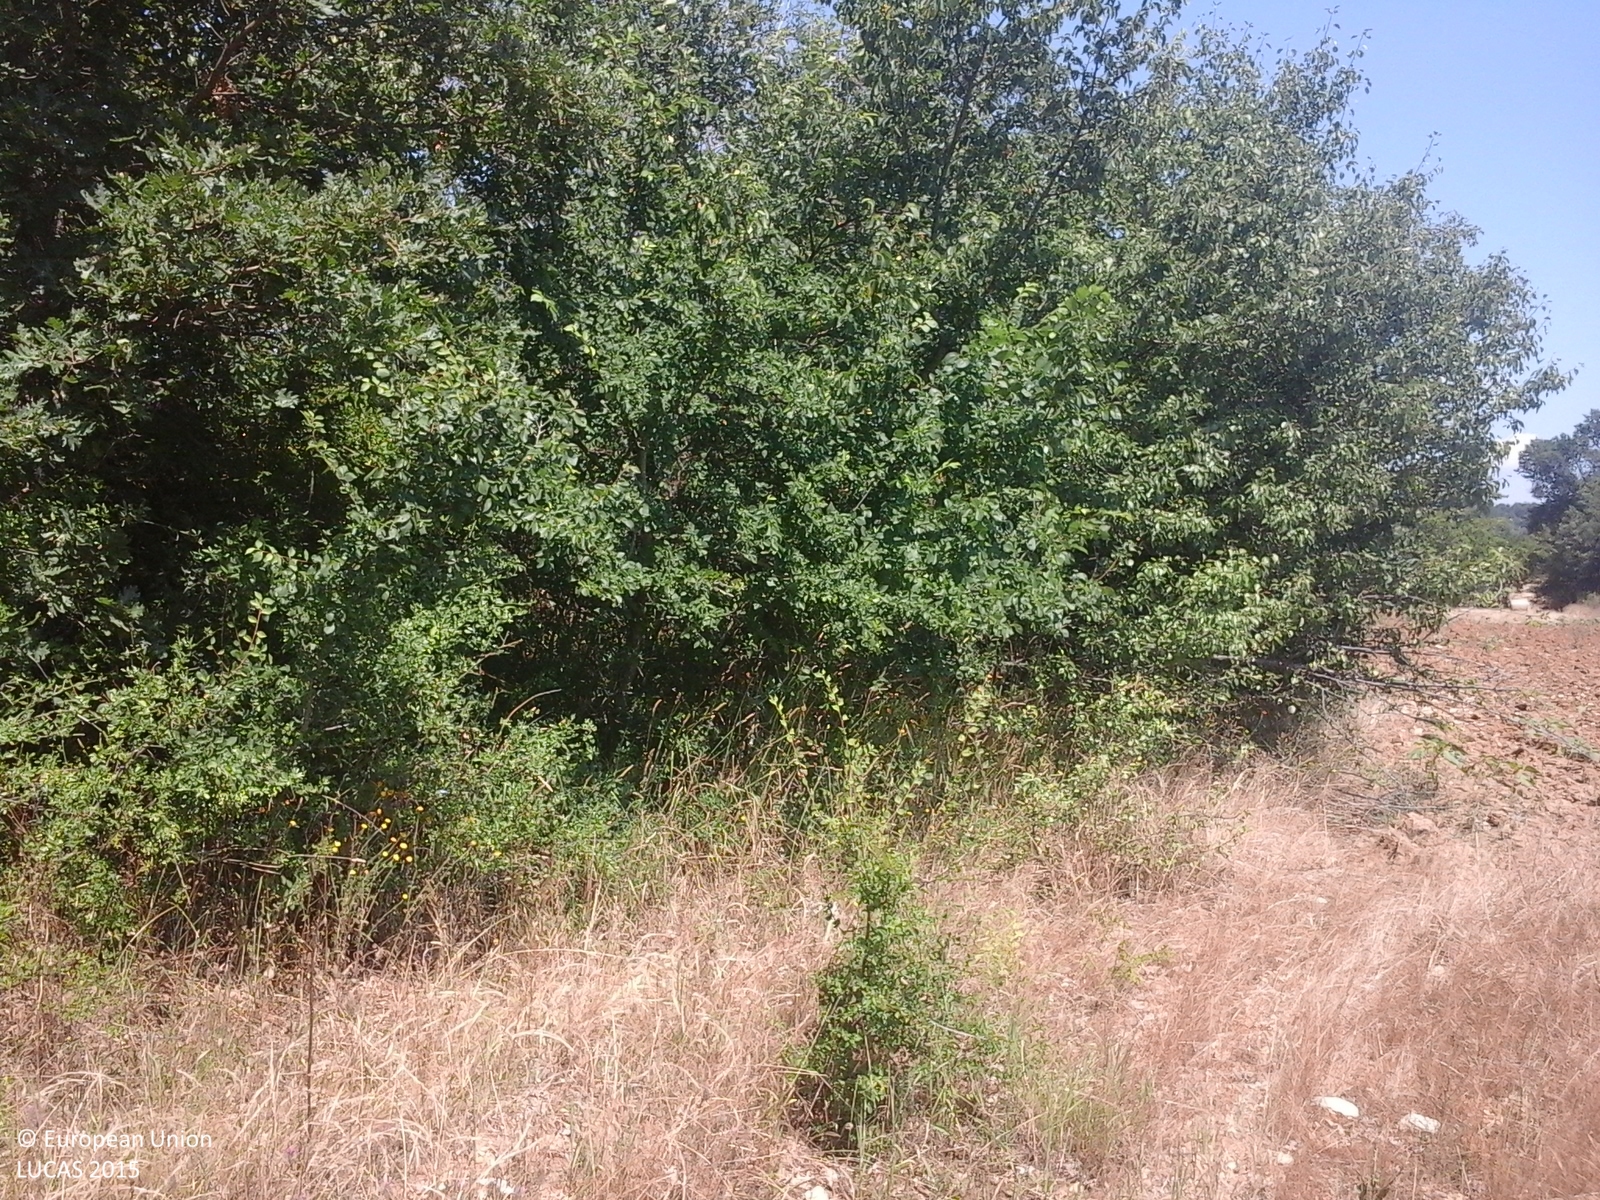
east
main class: Woodland
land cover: Broadleaved woodland
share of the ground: > 75 %
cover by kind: broadleaved forest trees 100 %
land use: Semi-natural and natural areas not in use
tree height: > 5 m
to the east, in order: Broadleaved woodland; Spontaneously vegetated surfaces; Broadleaved woodland; Spontaneously vegetated surfaces; Broadleaved woodland; Spontaneously vegetated surfaces
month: June
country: GR
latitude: 40.8368
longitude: 23.1881
